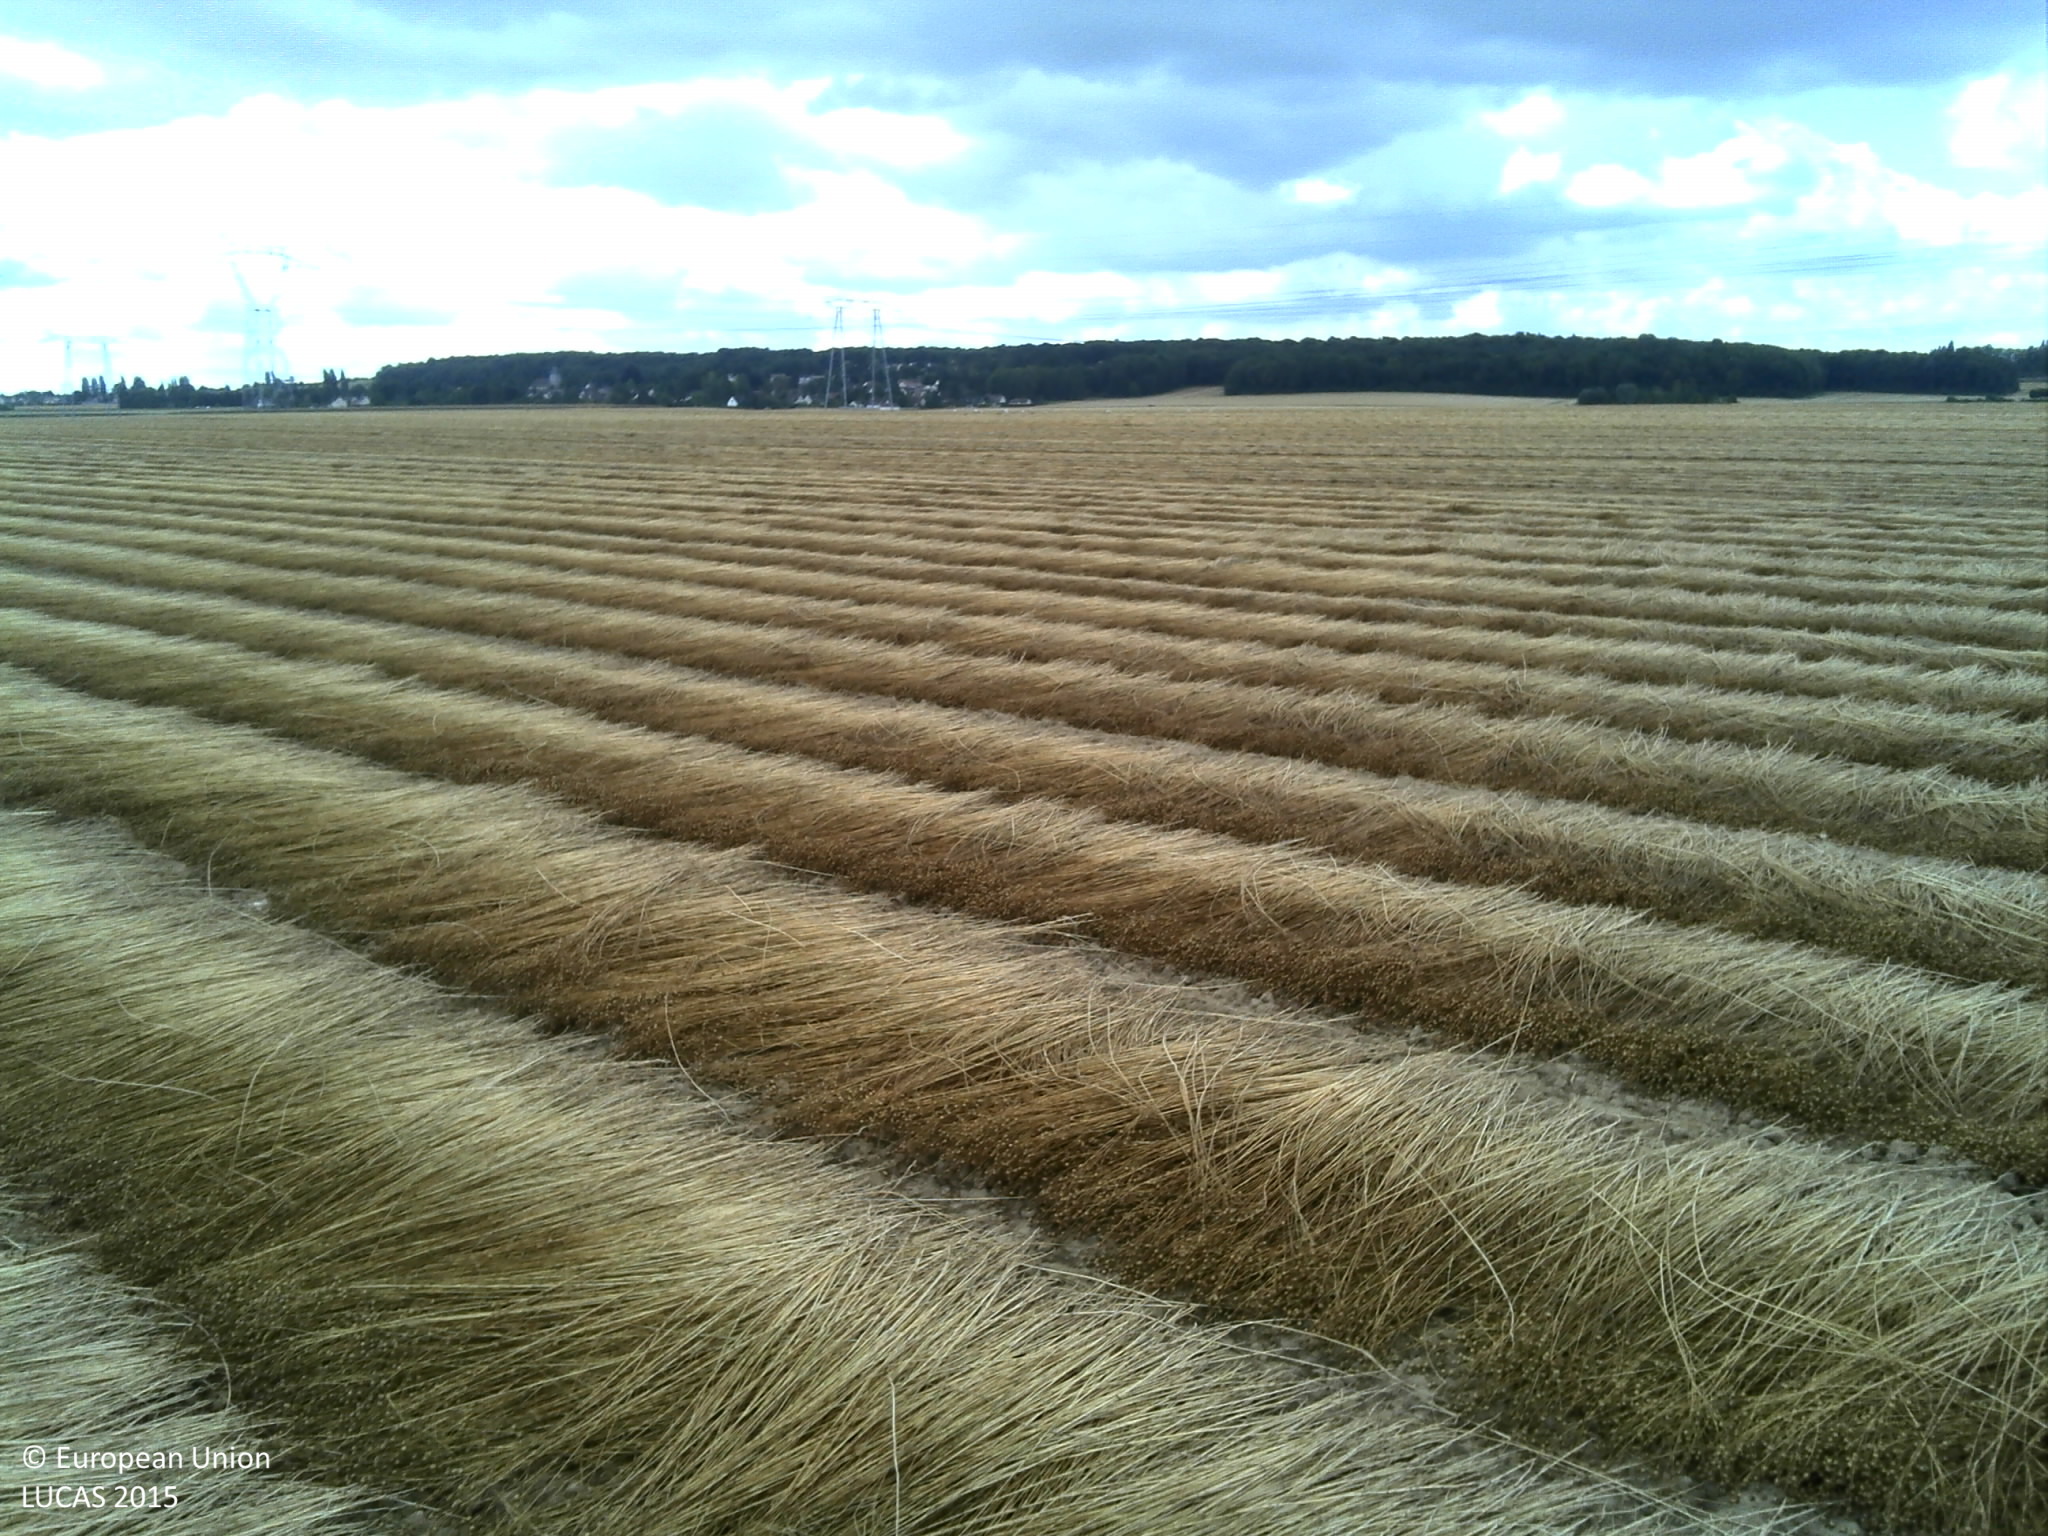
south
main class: Cropland
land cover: Other fibre and oleaginous crops
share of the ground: > 75 %
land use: Agriculture (excluding fallow land and kitchen gardens)
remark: Harvested field
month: July
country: FR
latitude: 48.8774
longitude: 1.8170
